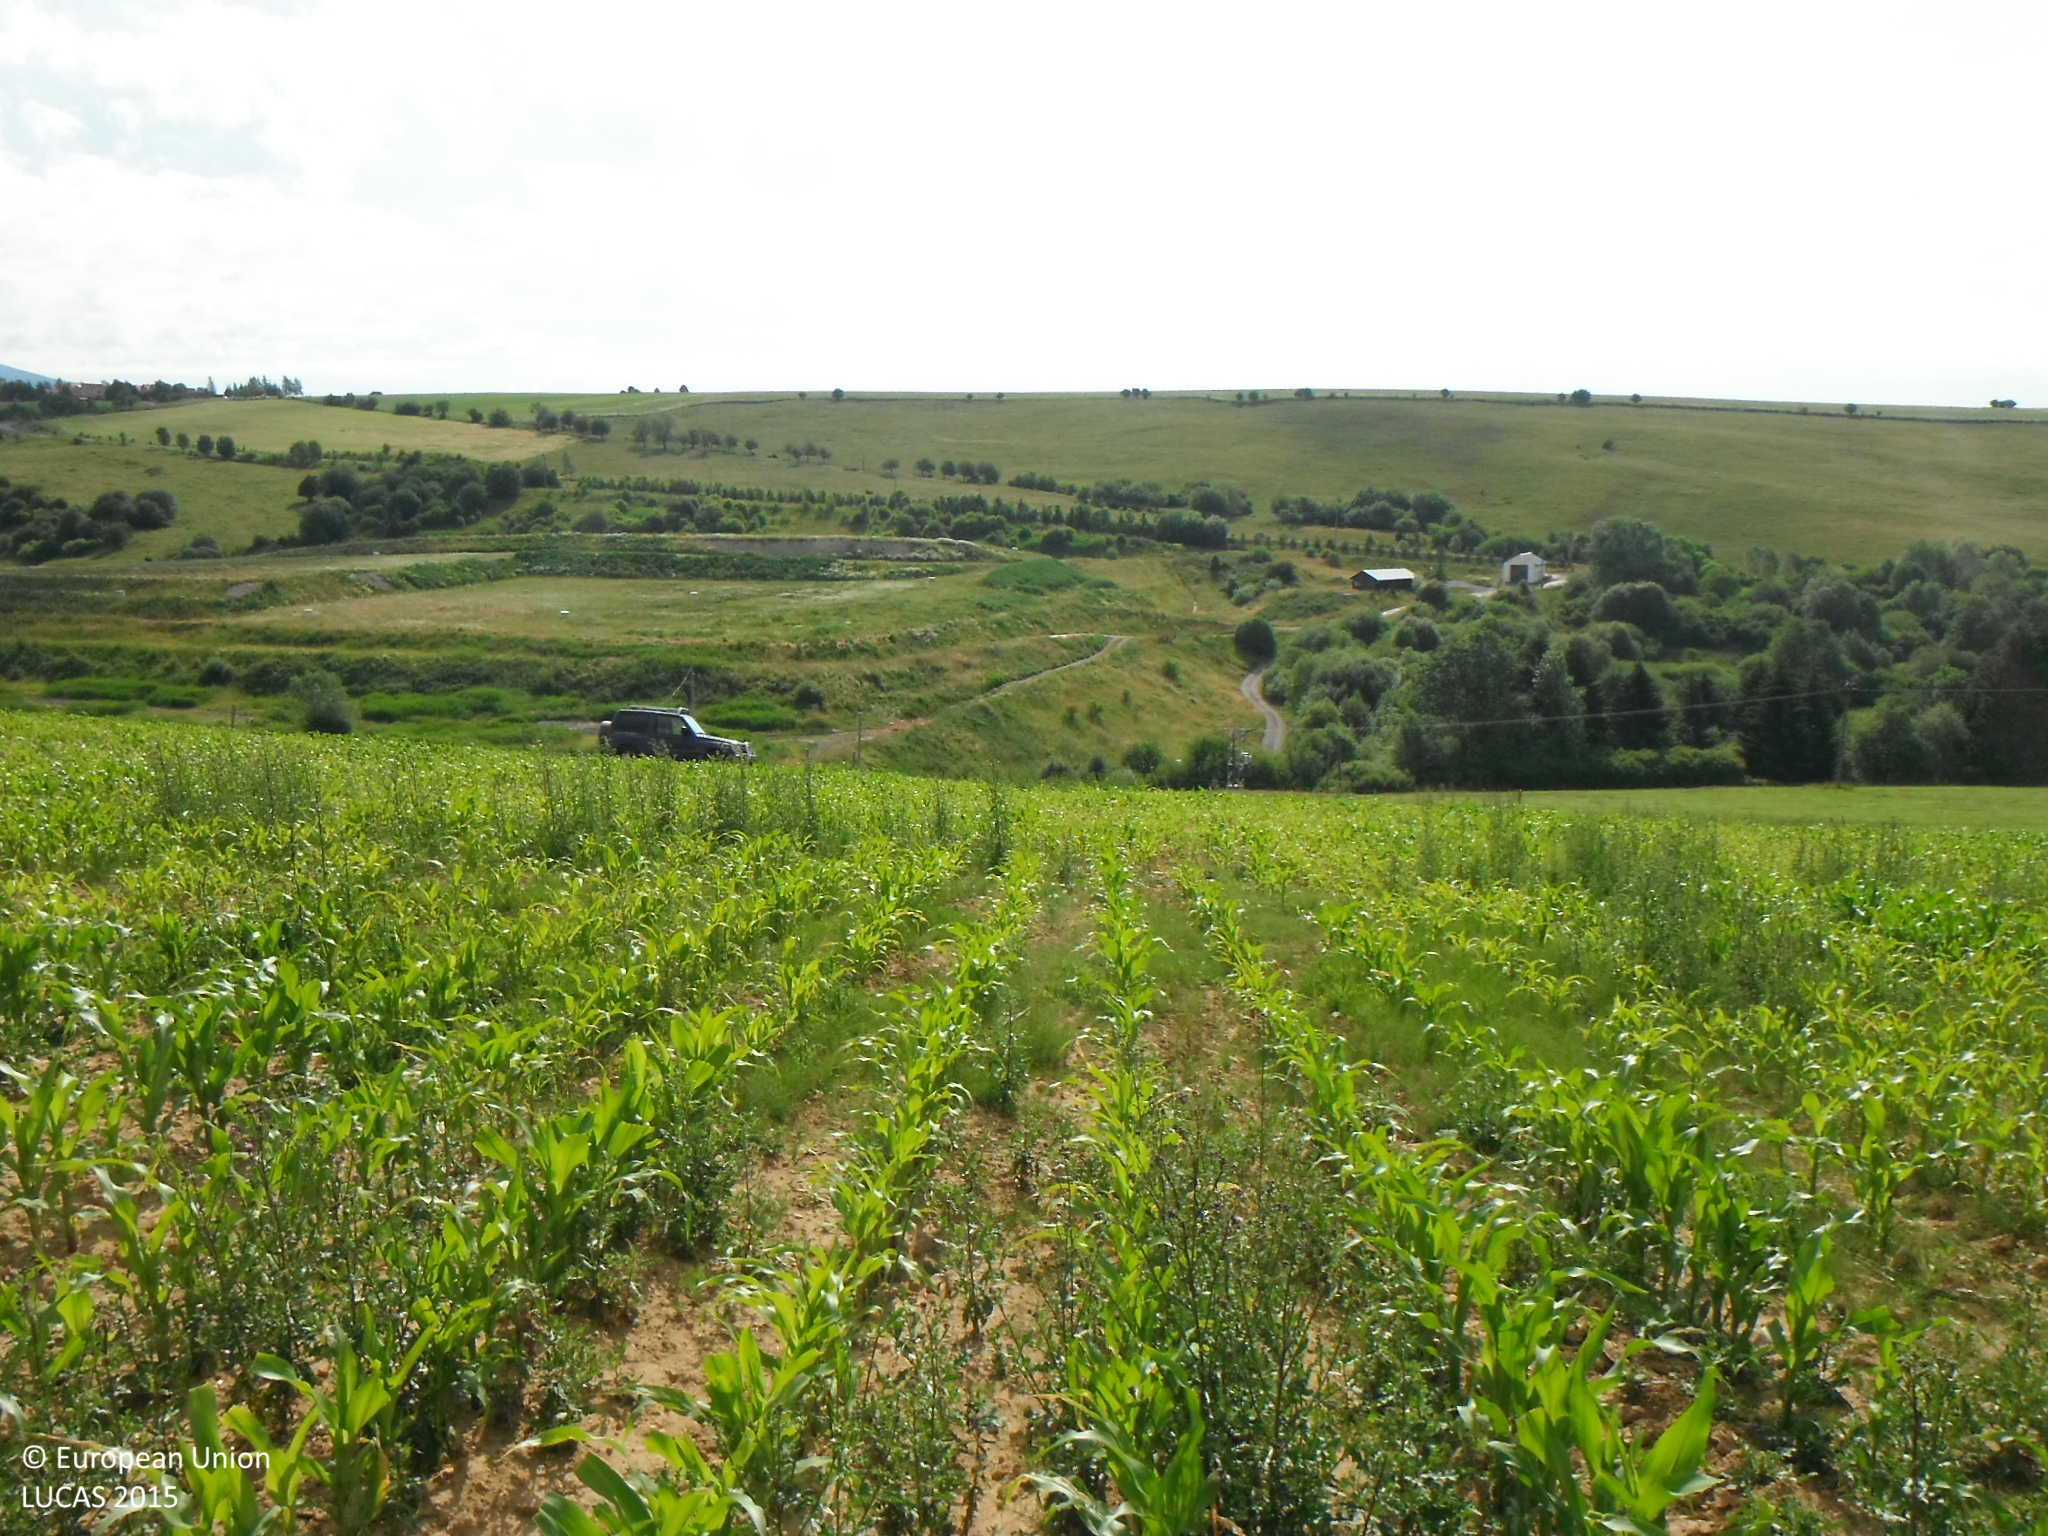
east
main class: Cropland
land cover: Maize
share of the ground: 50 - 75 %
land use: Agriculture (excluding fallow land and kitchen gardens)
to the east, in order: Maize; Tracks; Grassland without tree/shrub cover; Electric lines; Grassland without tree/shrub cover; Spontaneously vegetated surfaces; Fences; Grassland with sparse tree/shrub cover; Tracks; Grassland without tree/shrub cover; Tracks; Grassland without tree/shrub cover; Spontaneously vegetated surfaces
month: July
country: SK
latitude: 49.1032
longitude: 19.6567
